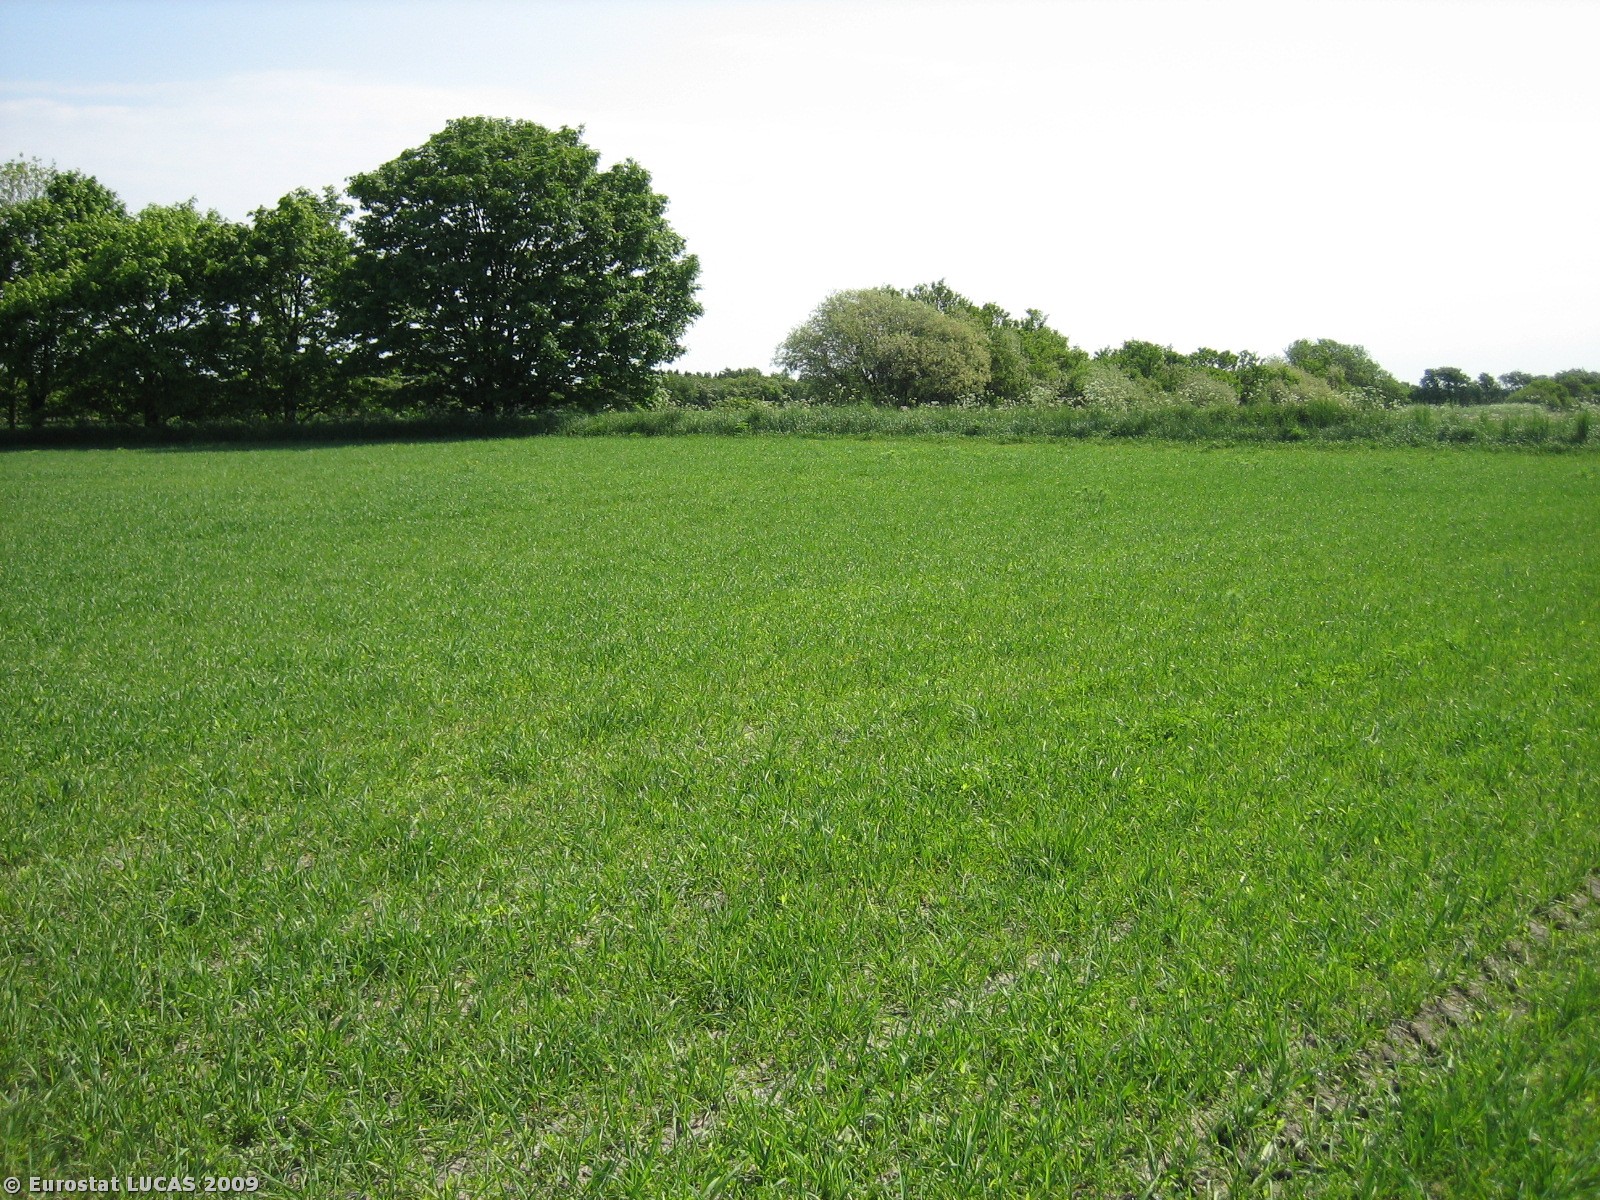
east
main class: Cropland
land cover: Barley
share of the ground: 50 - 75 %
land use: Agriculture (excluding fallow land and kitchen gardens)
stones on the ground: < 10 %
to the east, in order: Barley; Grass margins; Ditches and canals; Grassland without tree/shrub cover; Barley
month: May
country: DK
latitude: 56.1314
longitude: 9.2125
